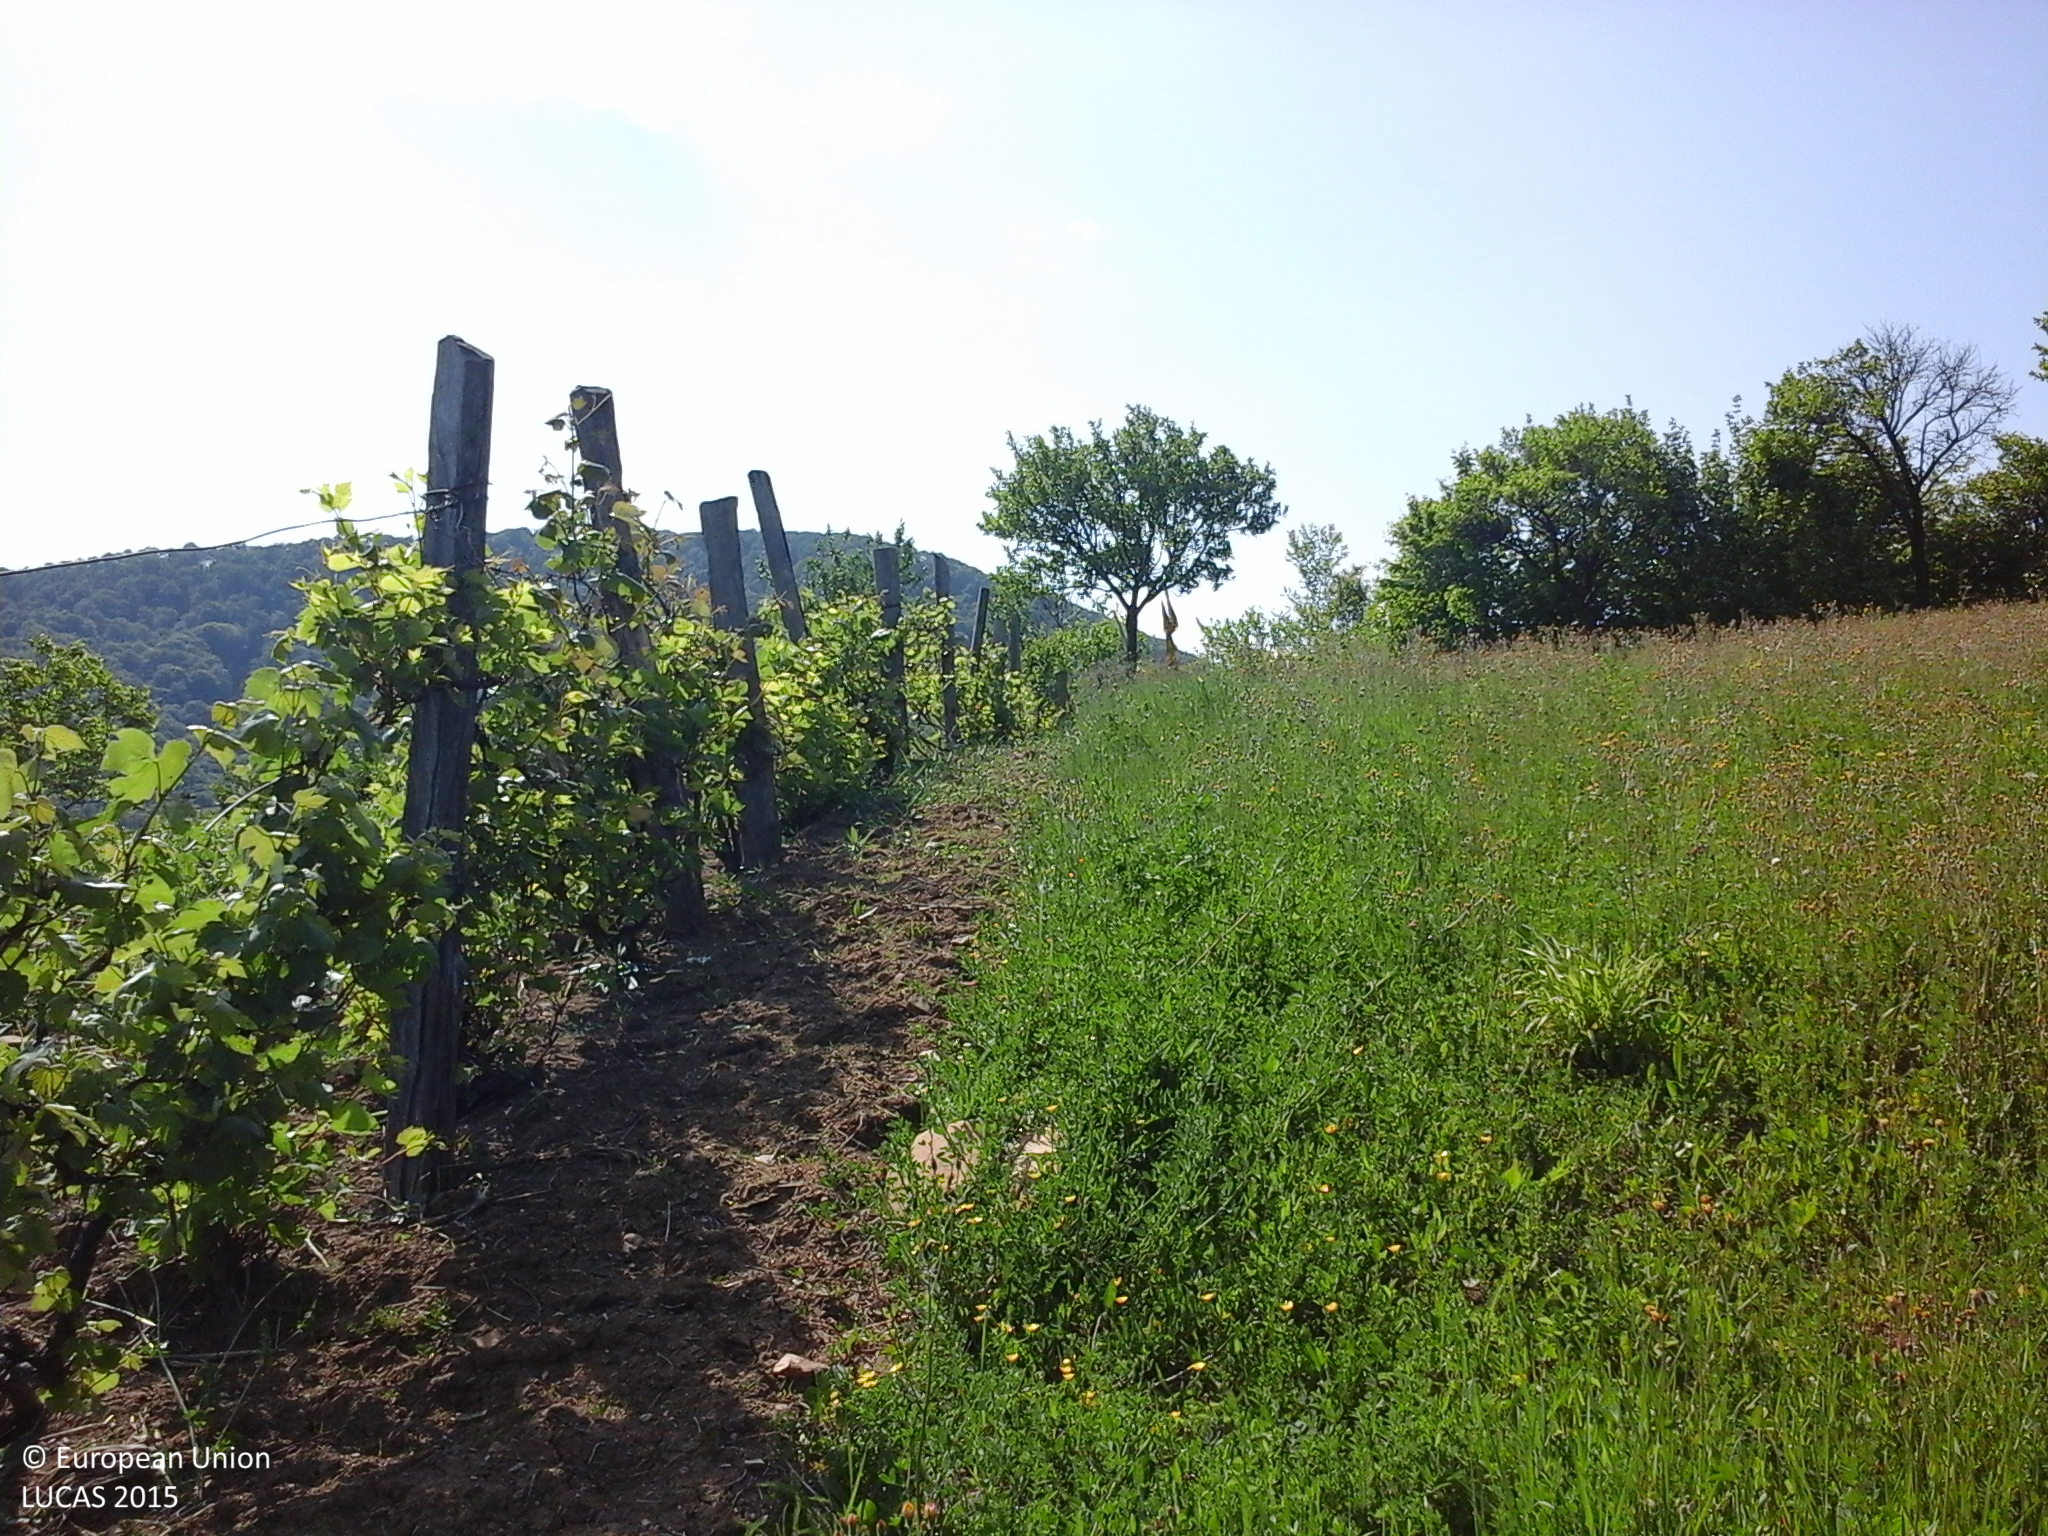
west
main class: Cropland
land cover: Other leguminous and mixtures for fodder
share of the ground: > 75 %
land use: Agriculture (excluding fallow land and kitchen gardens)
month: May
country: RO
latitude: 46.2167
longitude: 26.6109
